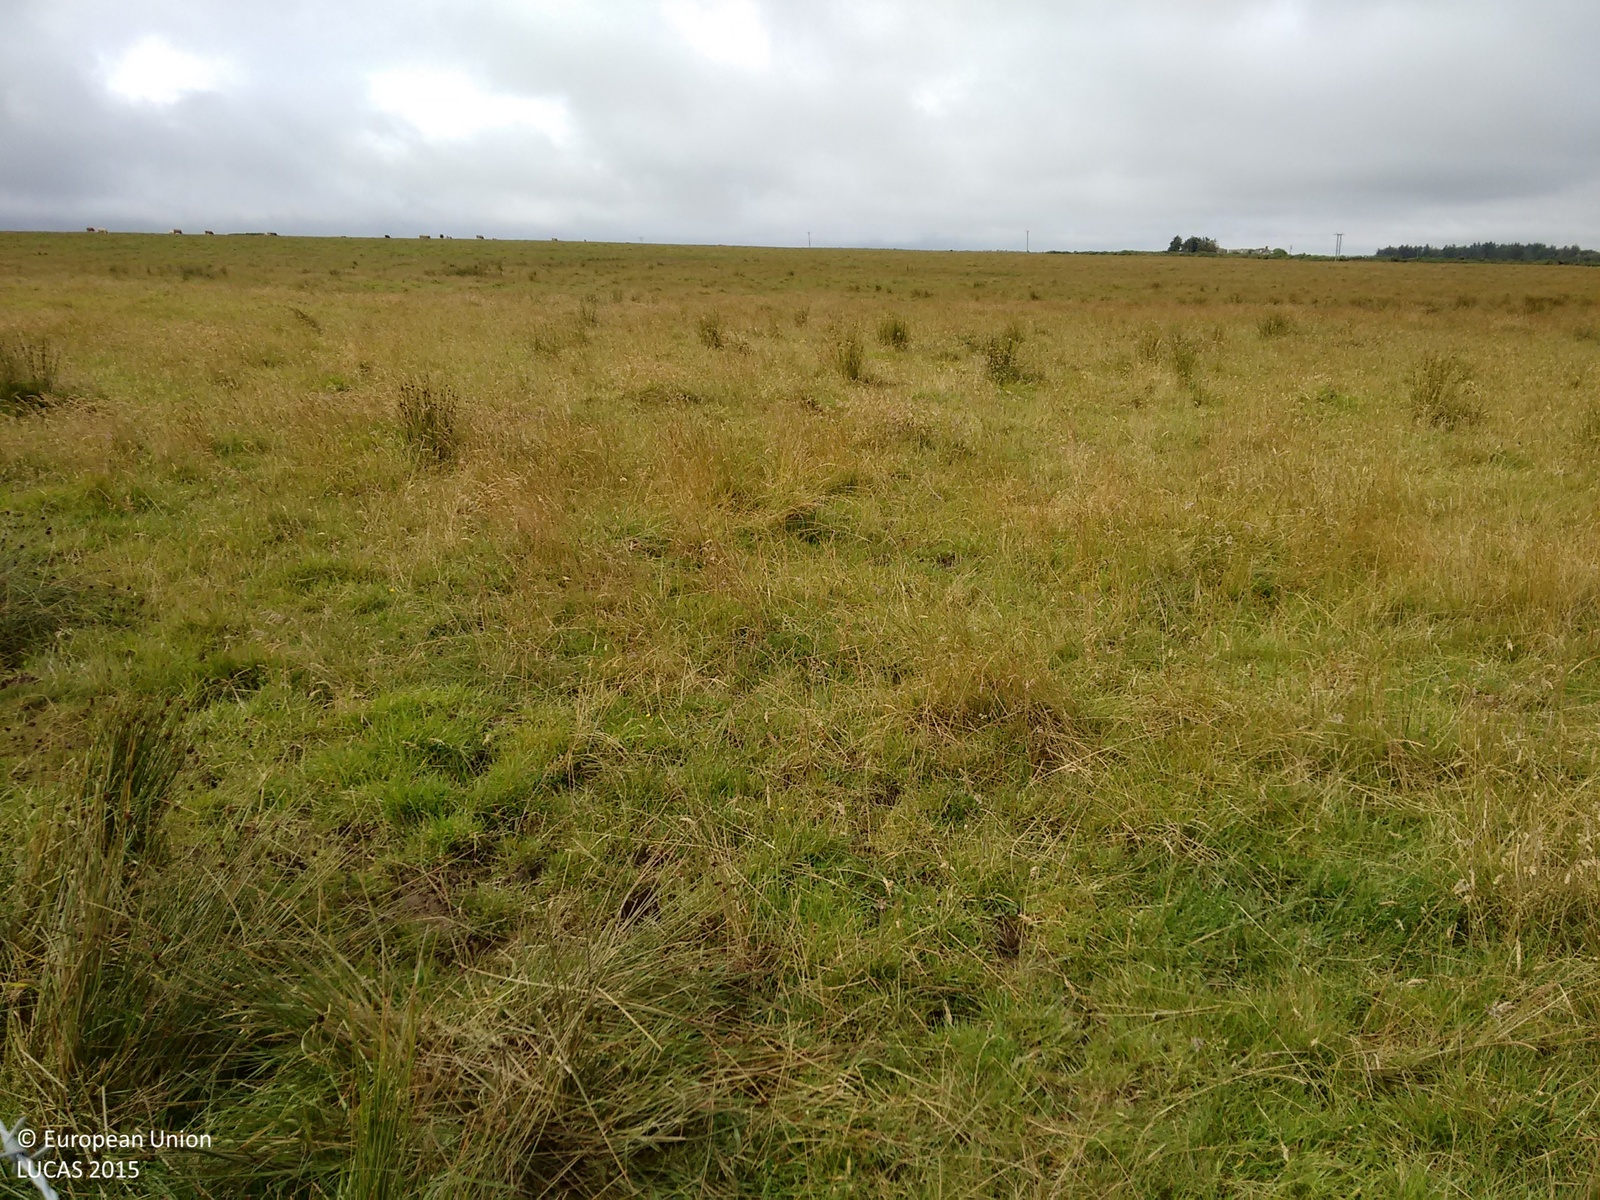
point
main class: Grassland
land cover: Grassland without tree/shrub cover
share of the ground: > 75 %
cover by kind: herbaceous plants 100 %
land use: Agriculture (excluding fallow land and kitchen gardens)
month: August
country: GB
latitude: 58.5264
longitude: -3.2655
